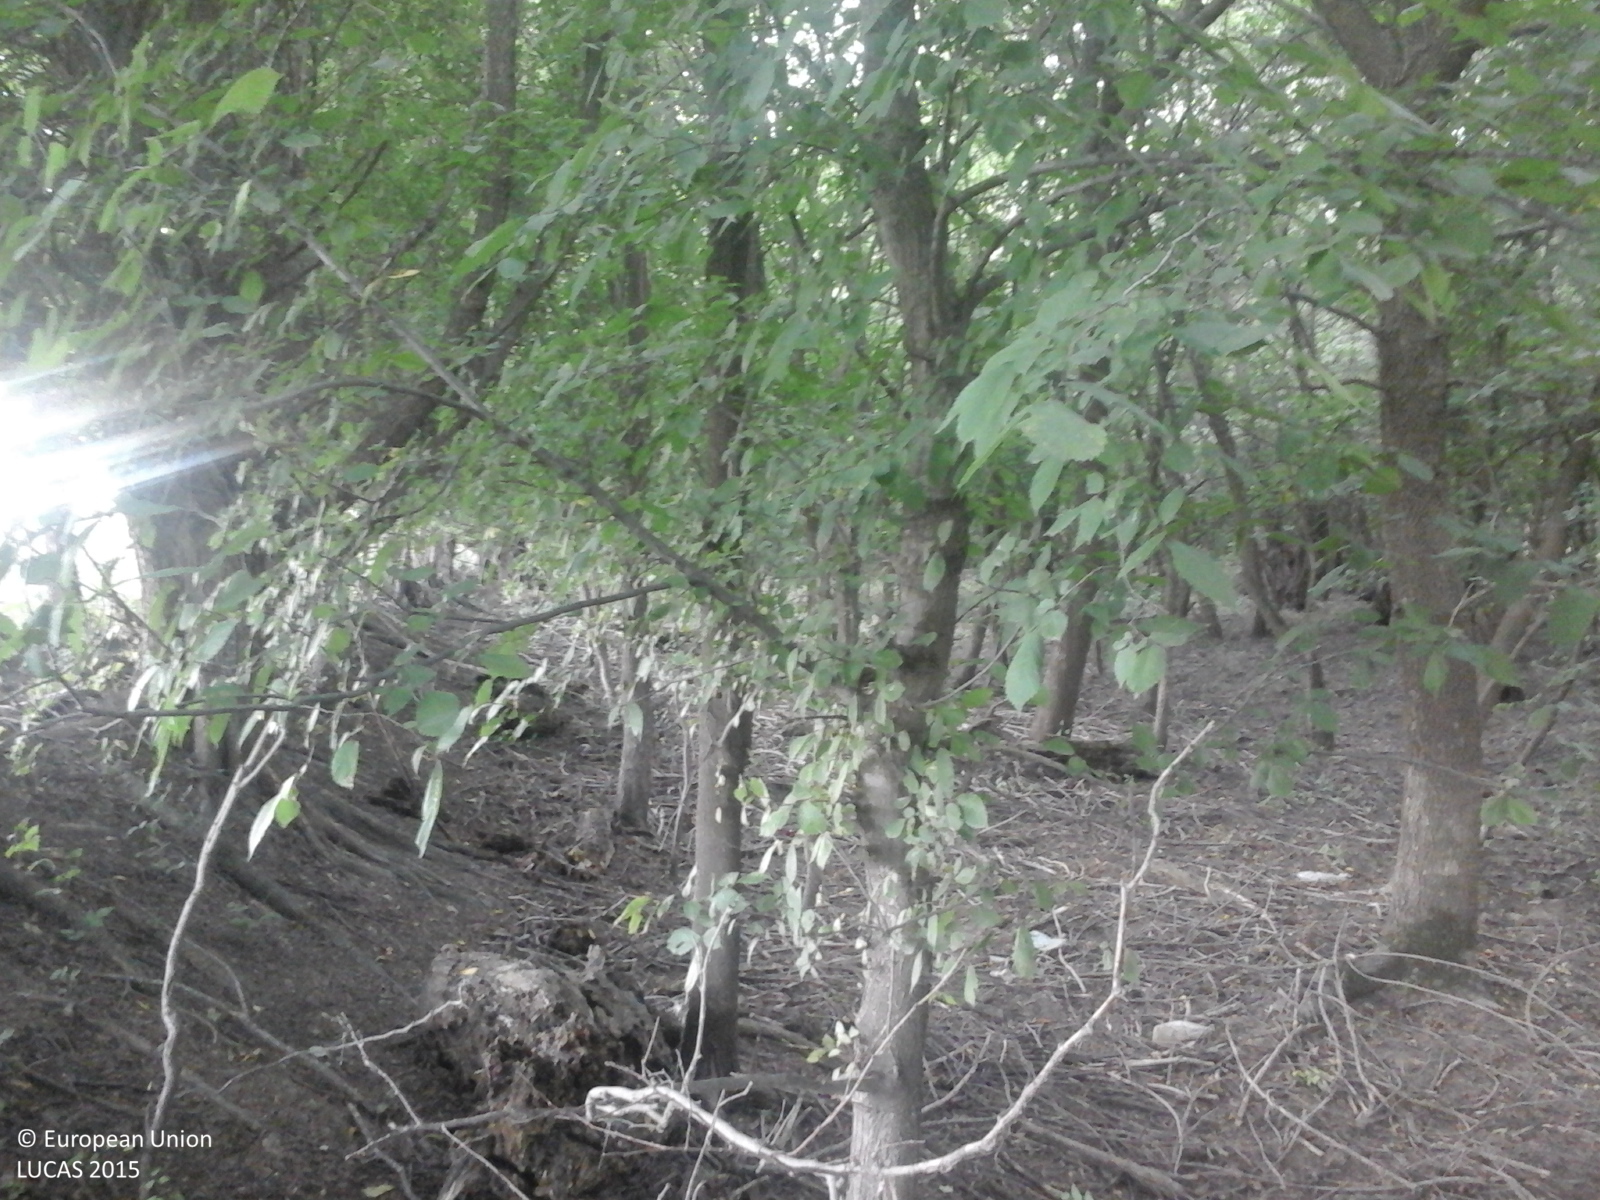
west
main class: Woodland
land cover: Broadleaved woodland
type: floodplain forest
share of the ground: > 75 %
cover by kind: broadleaved forest trees 100 %
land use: Forestry
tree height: > 5 m
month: August
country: RO
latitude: 44.2364
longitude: 27.8933
